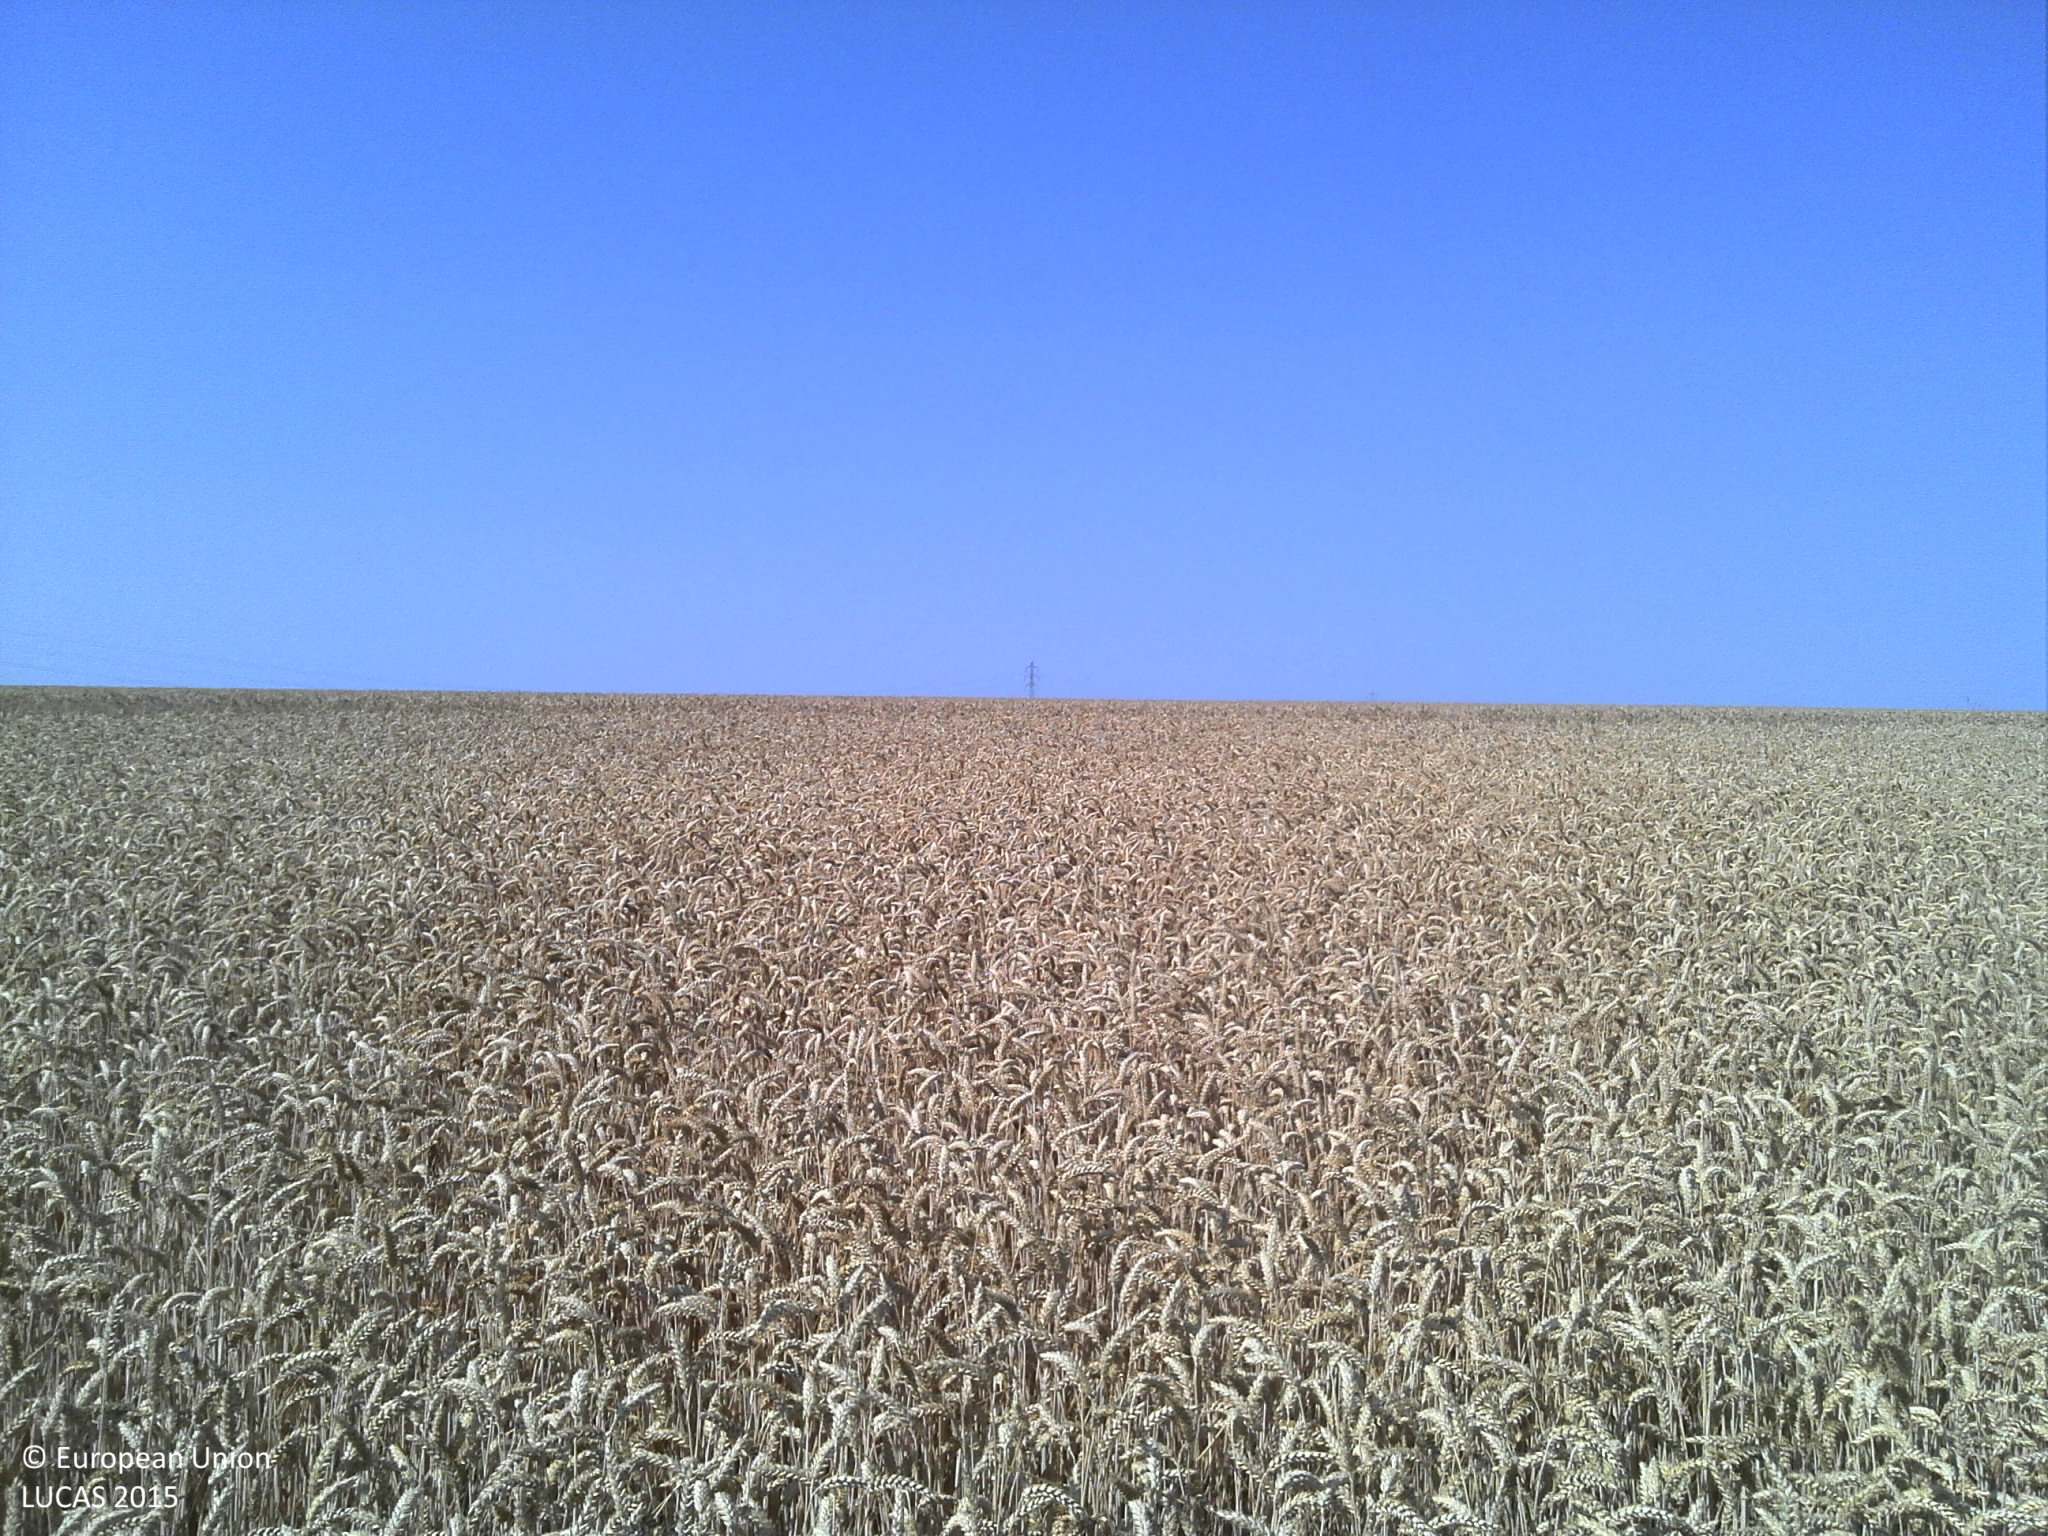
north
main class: Cropland
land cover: Common wheat
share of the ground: > 75 %
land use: Agriculture (excluding fallow land and kitchen gardens)
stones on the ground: < 10 %
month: July
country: FR
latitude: 49.4632
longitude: 4.2696
